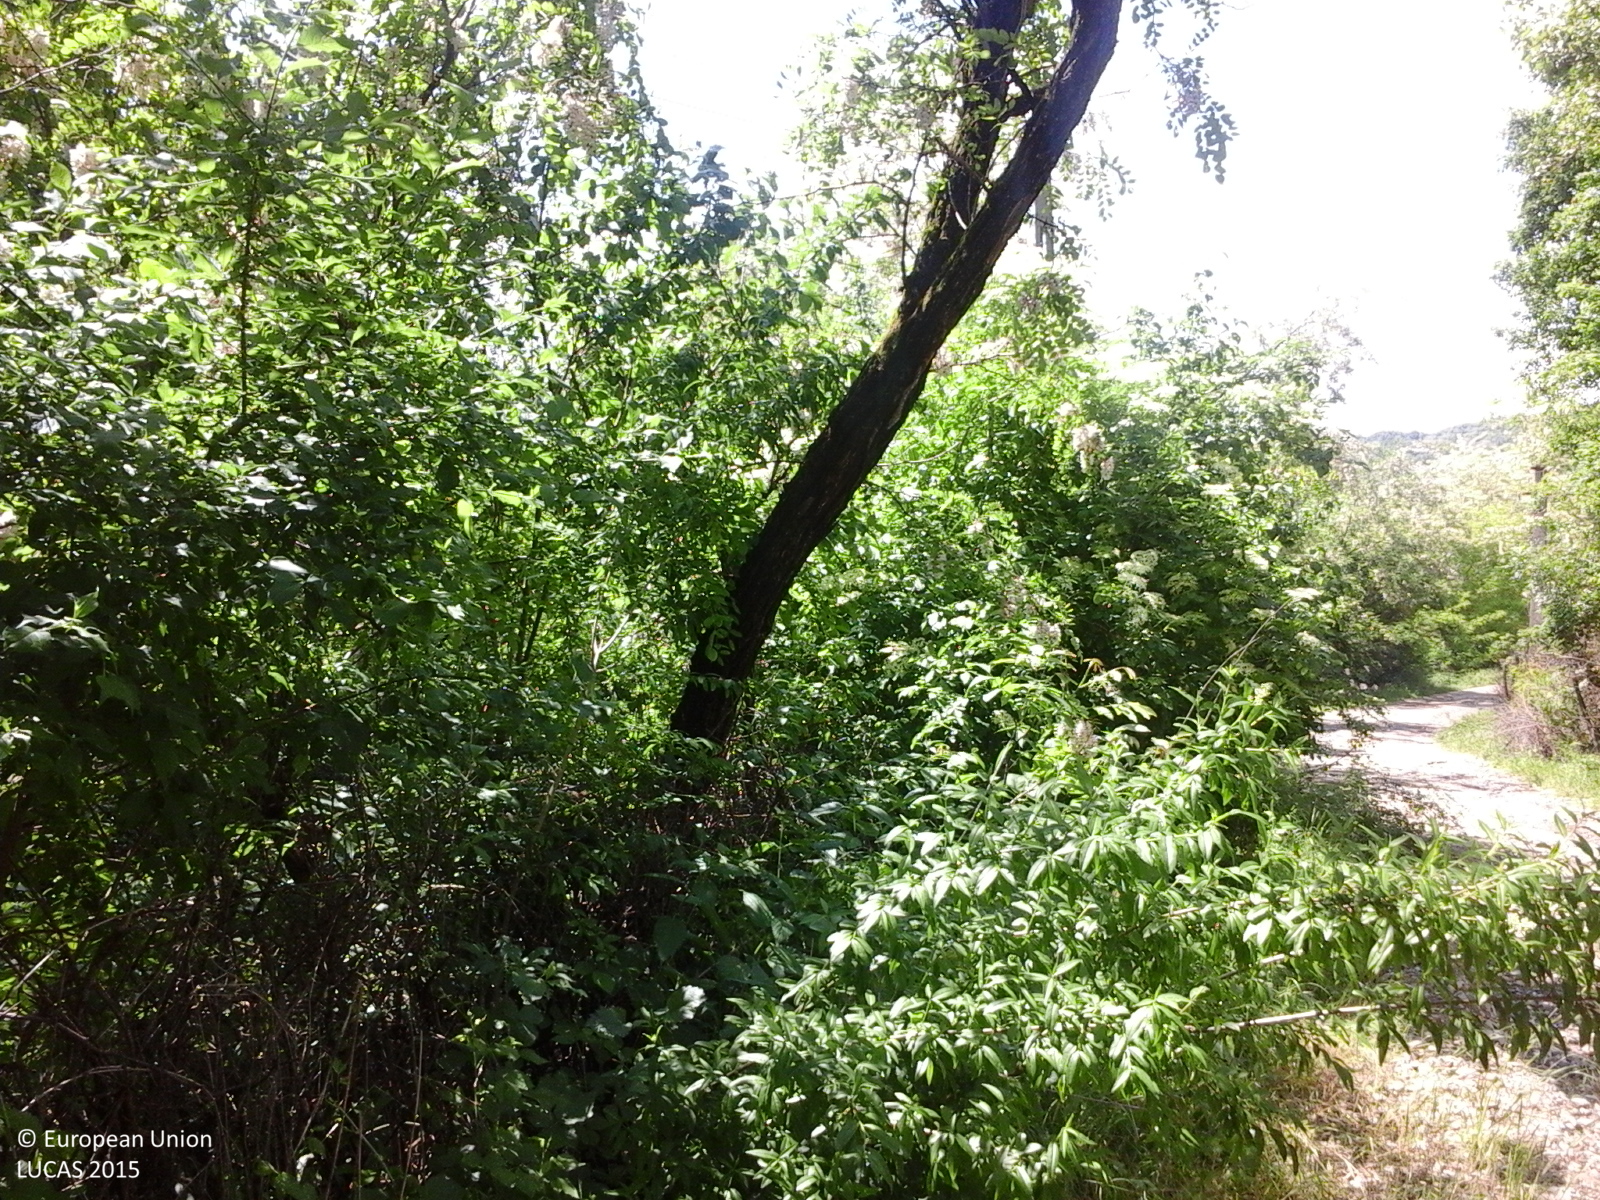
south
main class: Woodland
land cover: Broadleaved woodland
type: beech forest
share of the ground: > 75 %
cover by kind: broadleaved forest trees 90 %, shrubs 5 %, herbaceous plants 5 %
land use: Forestry
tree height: > 5 m
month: May
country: RO
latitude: 45.2338
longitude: 26.2032
